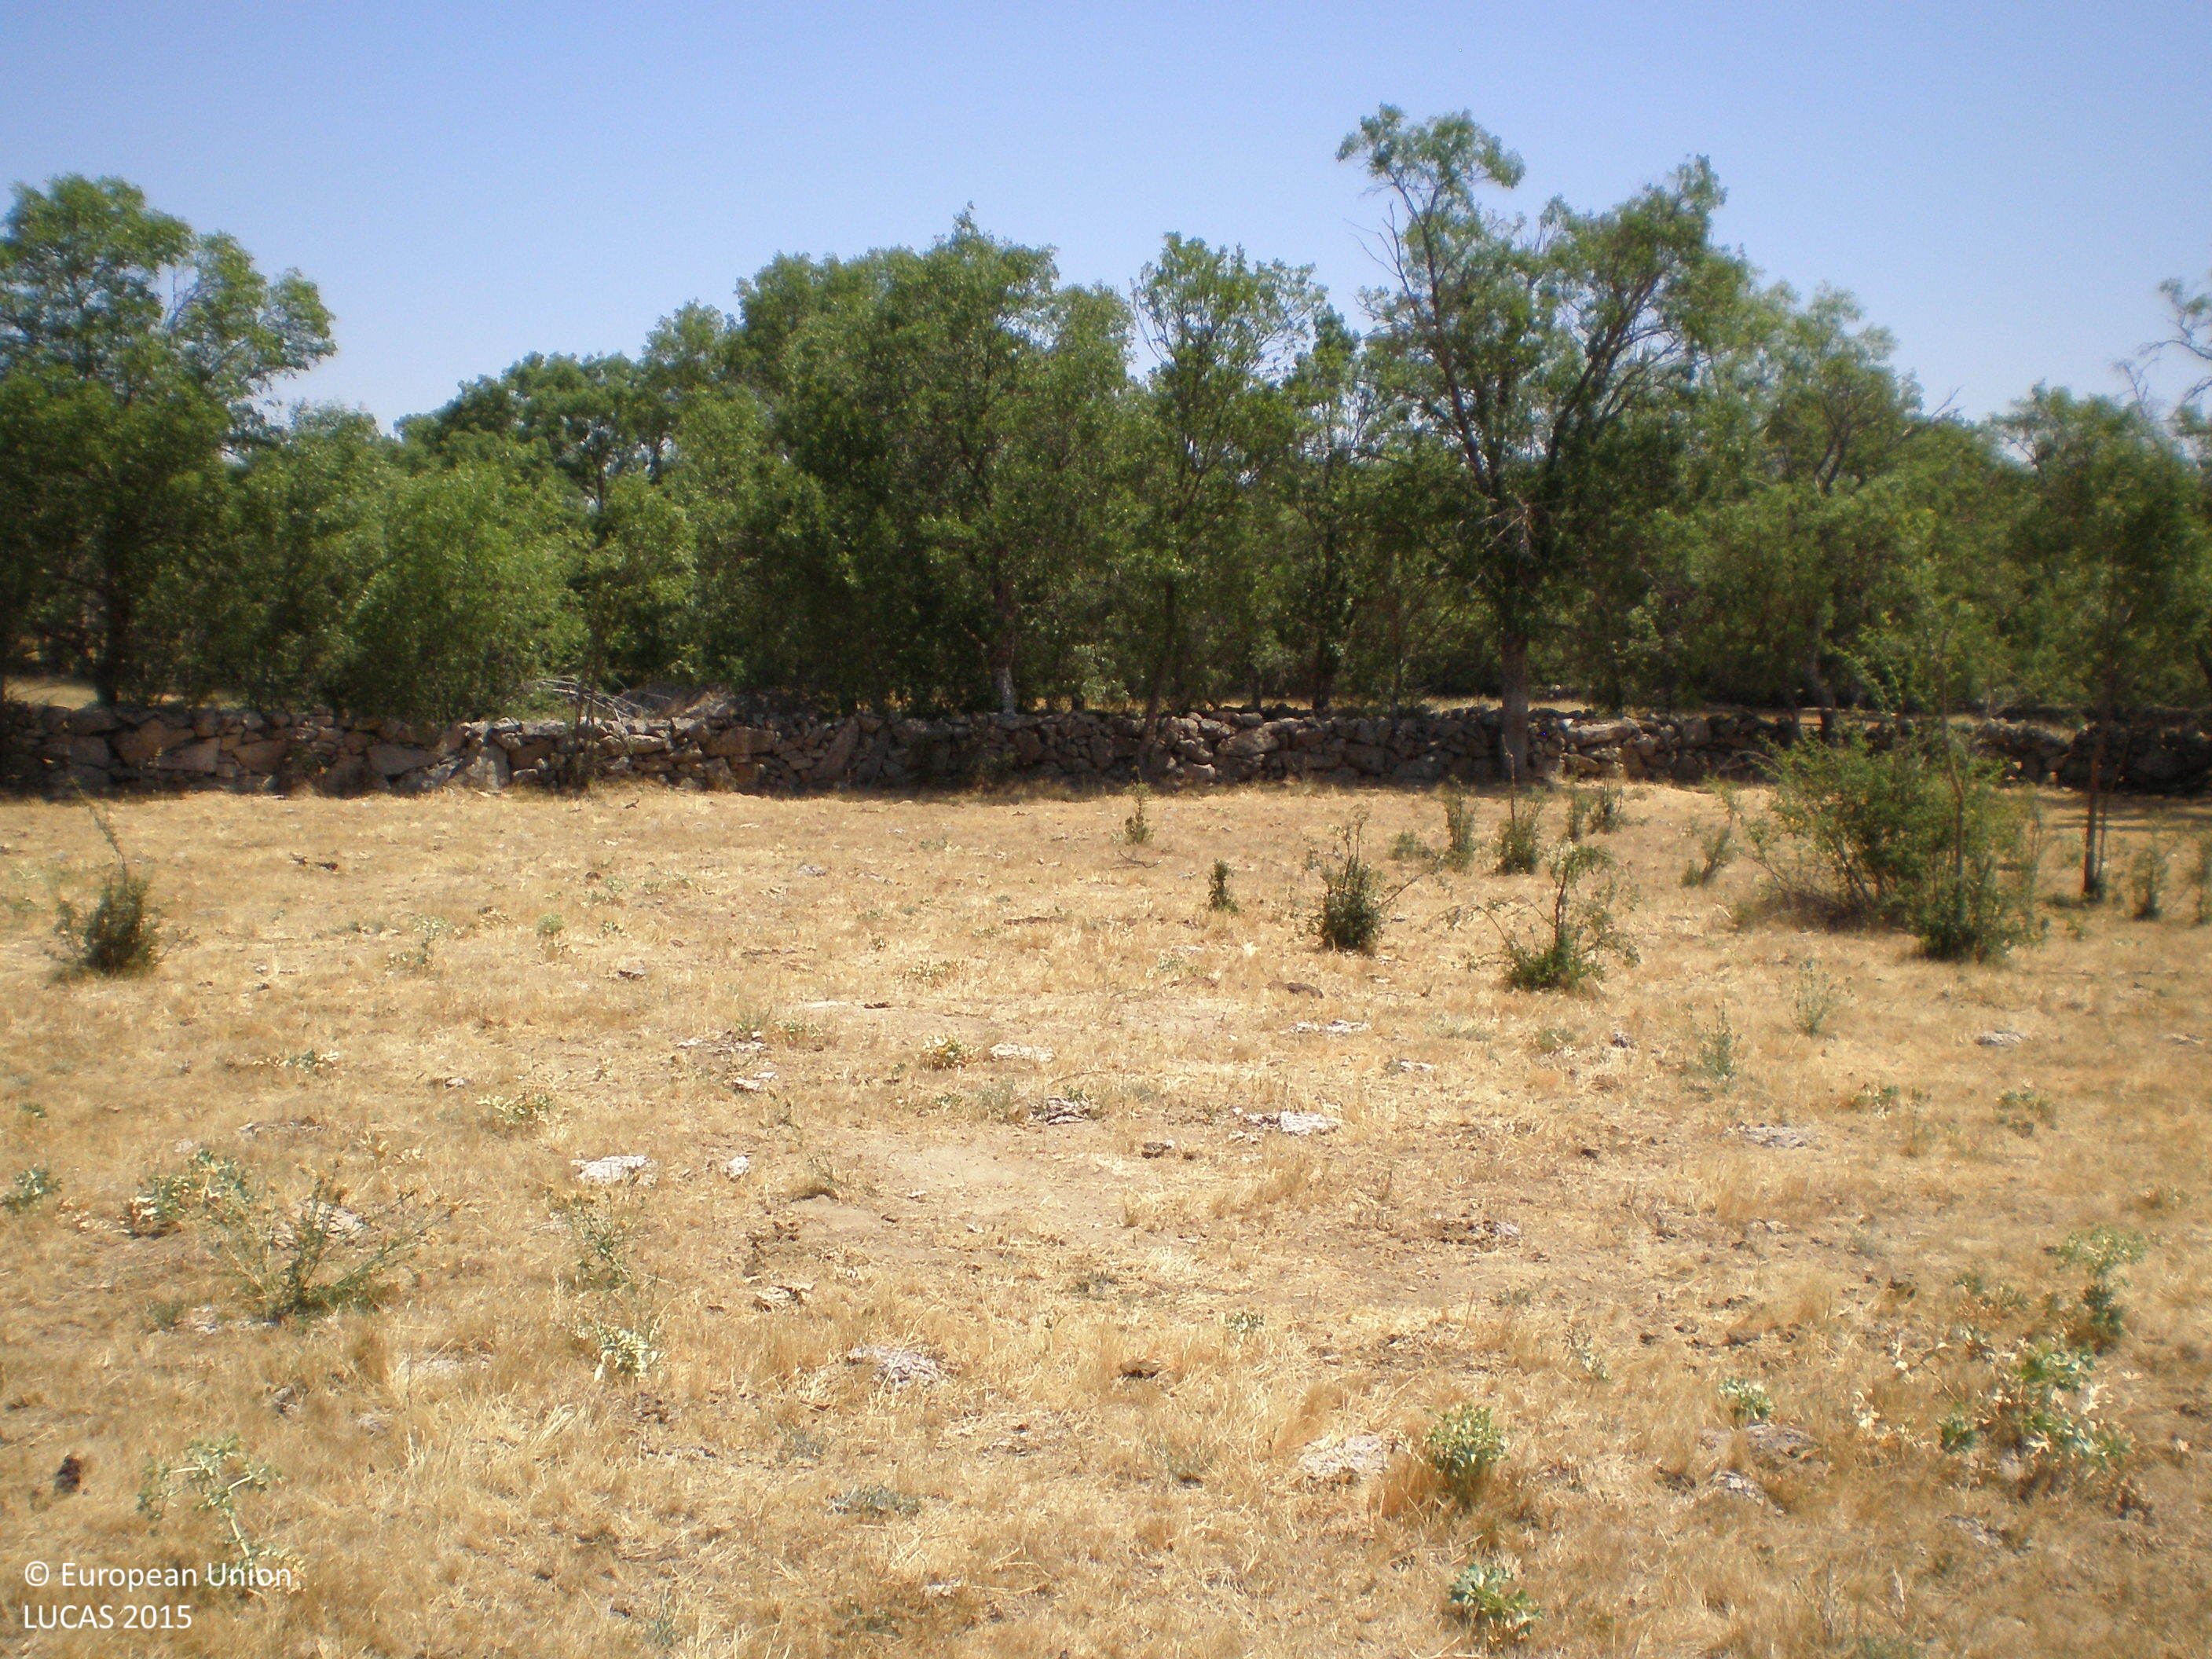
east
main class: Grassland
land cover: Grassland with sparse tree/shrub cover
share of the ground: > 75 %
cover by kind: herbaceous plants 95 %, broadleaved forest trees 5 %
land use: Agriculture (excluding fallow land and kitchen gardens)
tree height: < 5 m
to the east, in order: Grassland with sparse tree/shrub cover; Grassland without tree/shrub cover; Dry stone walls; Grassland without tree/shrub cover; Dry stone walls; Abandoned hedges; Grassland without tree/shrub cover; Dry stone walls; Grassland without tree/shrub cover; Dry stone walls; Abandoned hedges; Grassland without tree/shrub cover; Dry stone walls; Abandoned hedges; Grassland without tree/shrub cover; Dry stone walls; Abandoned hedges; Grassland without tree/shrub cover; Dry stone walls; Abandoned hedges; Grassland without tree/shrub cover
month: July
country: ES
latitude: 40.4137
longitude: -5.5641
